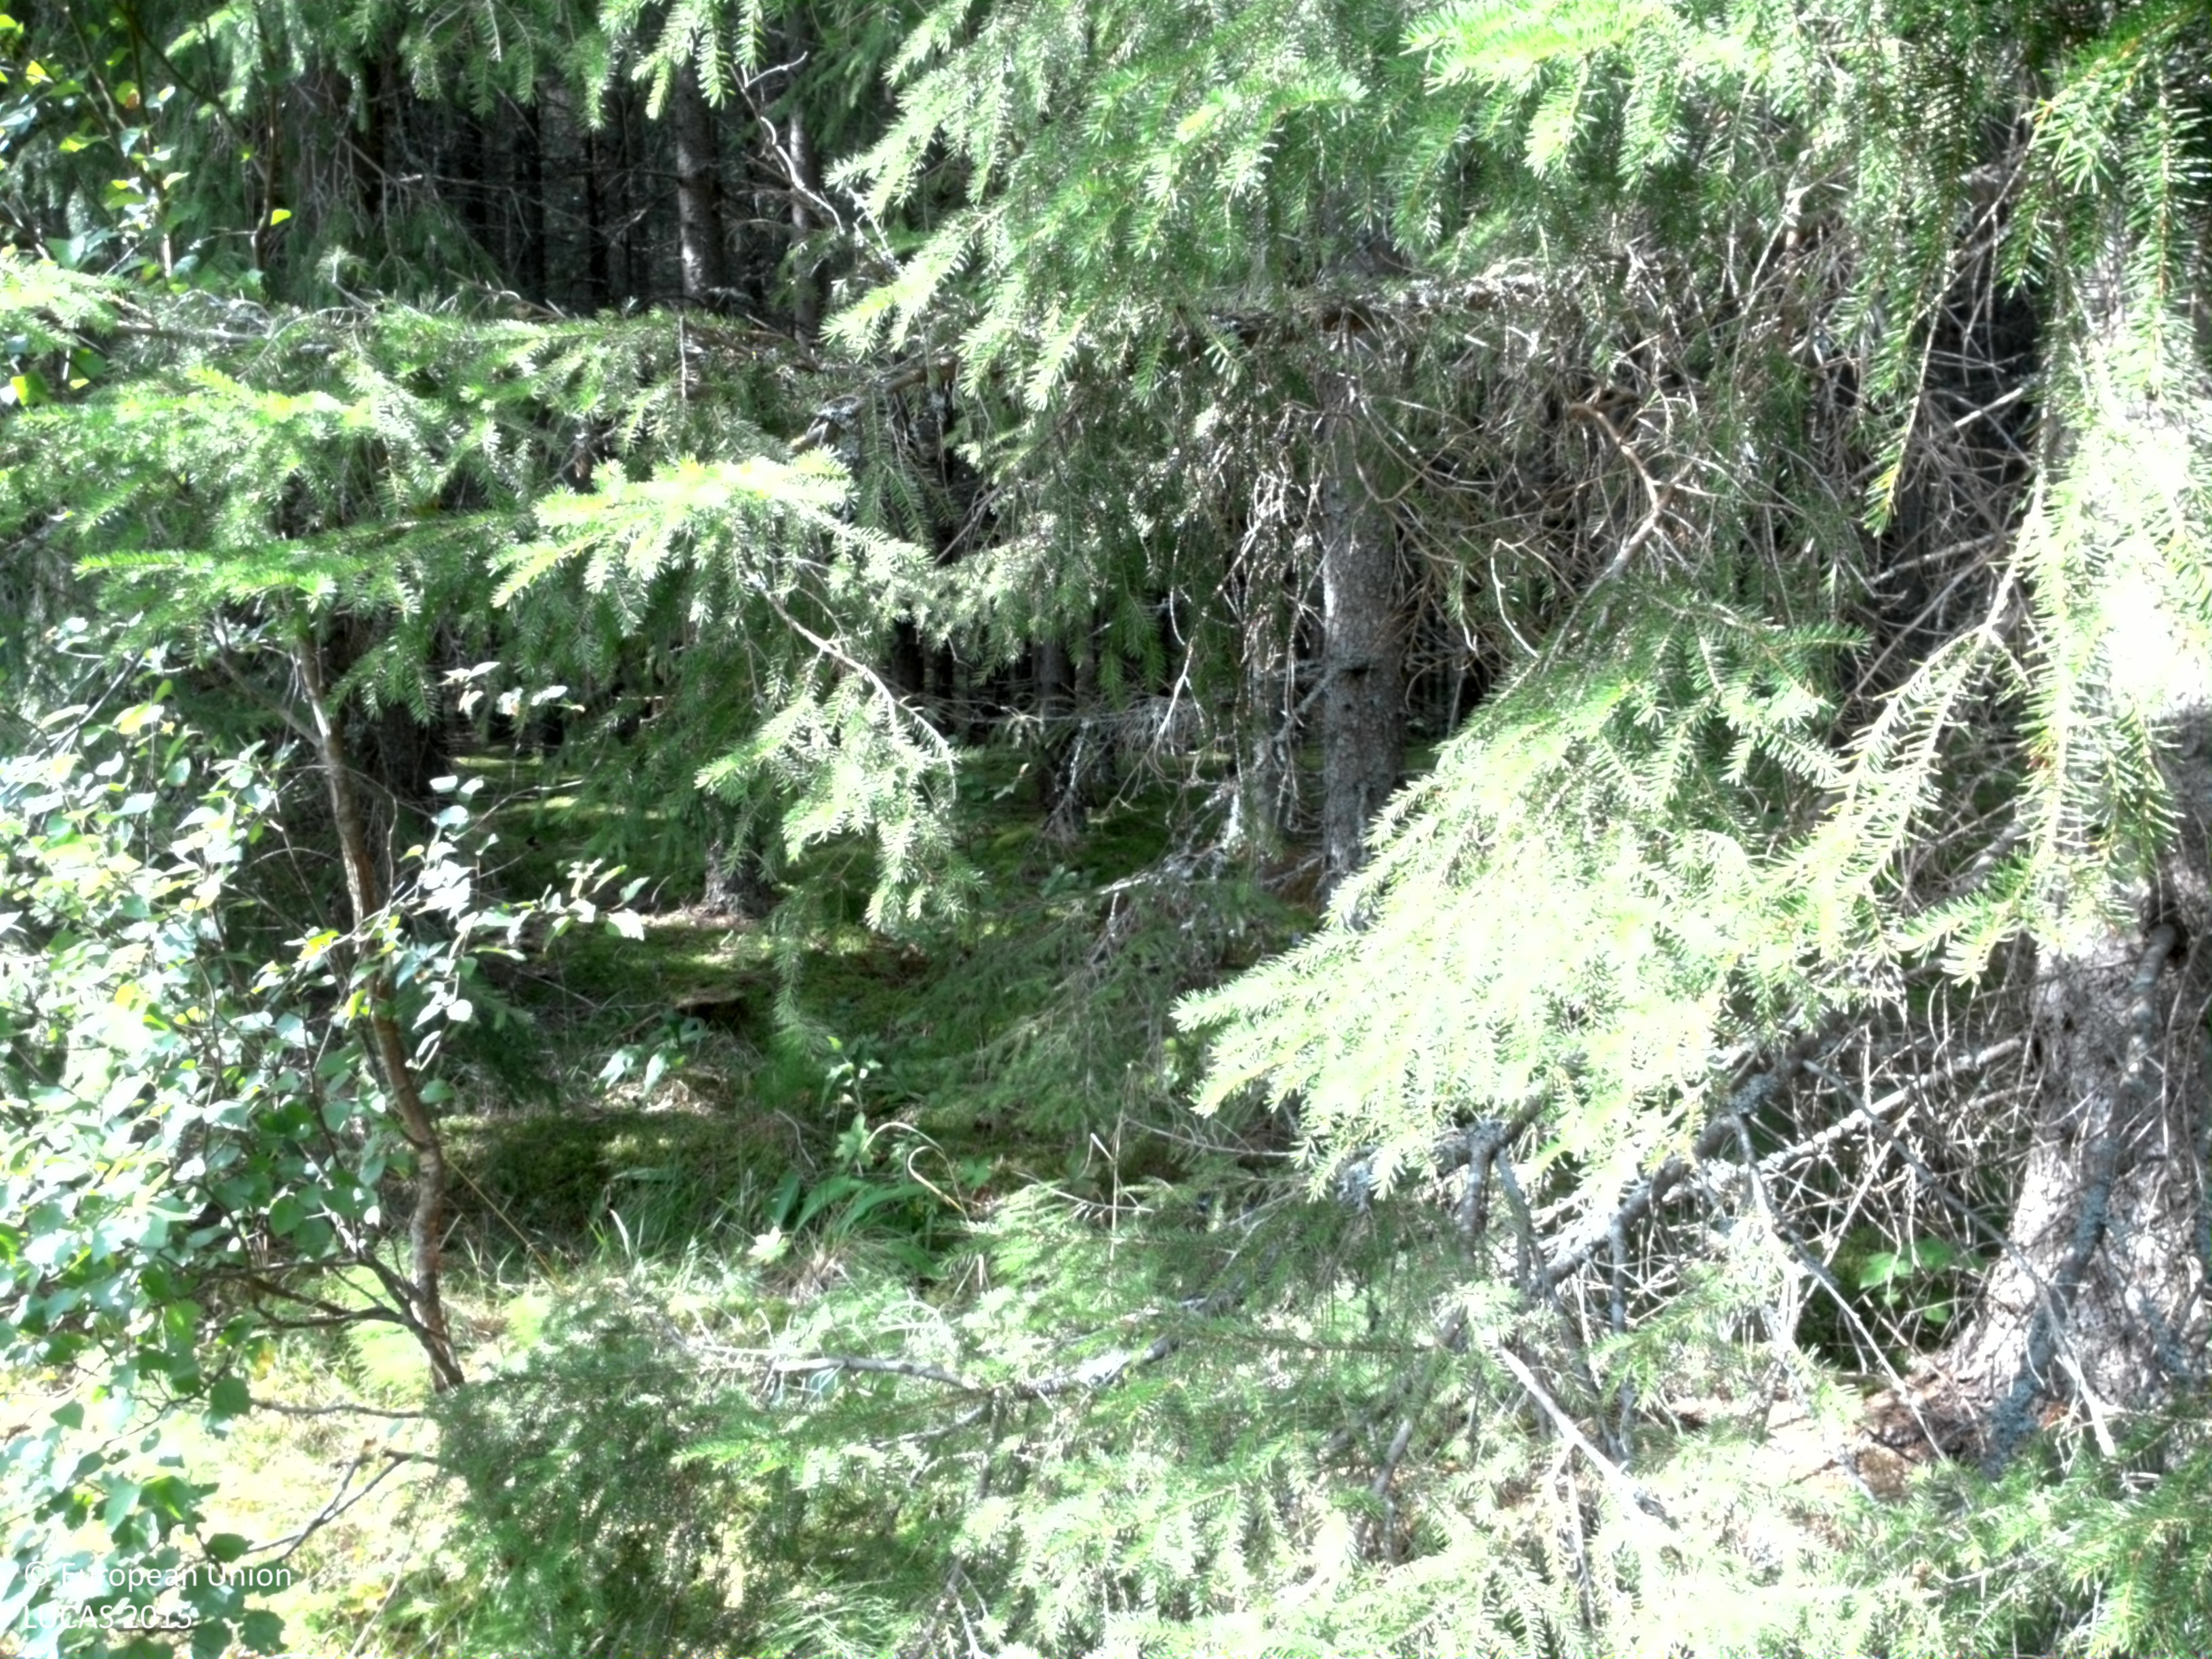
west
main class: Woodland
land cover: Spruce dominated mixed woodland
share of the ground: 25 - 50 %
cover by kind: herbaceous plants 70 %, broadleaved forest trees 20 %, coniferous forest trees 10 %
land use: Forestry
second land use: Amenities, museums, leisure
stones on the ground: < 10 %
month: August
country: SE
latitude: 59.7899
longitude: 15.8167
